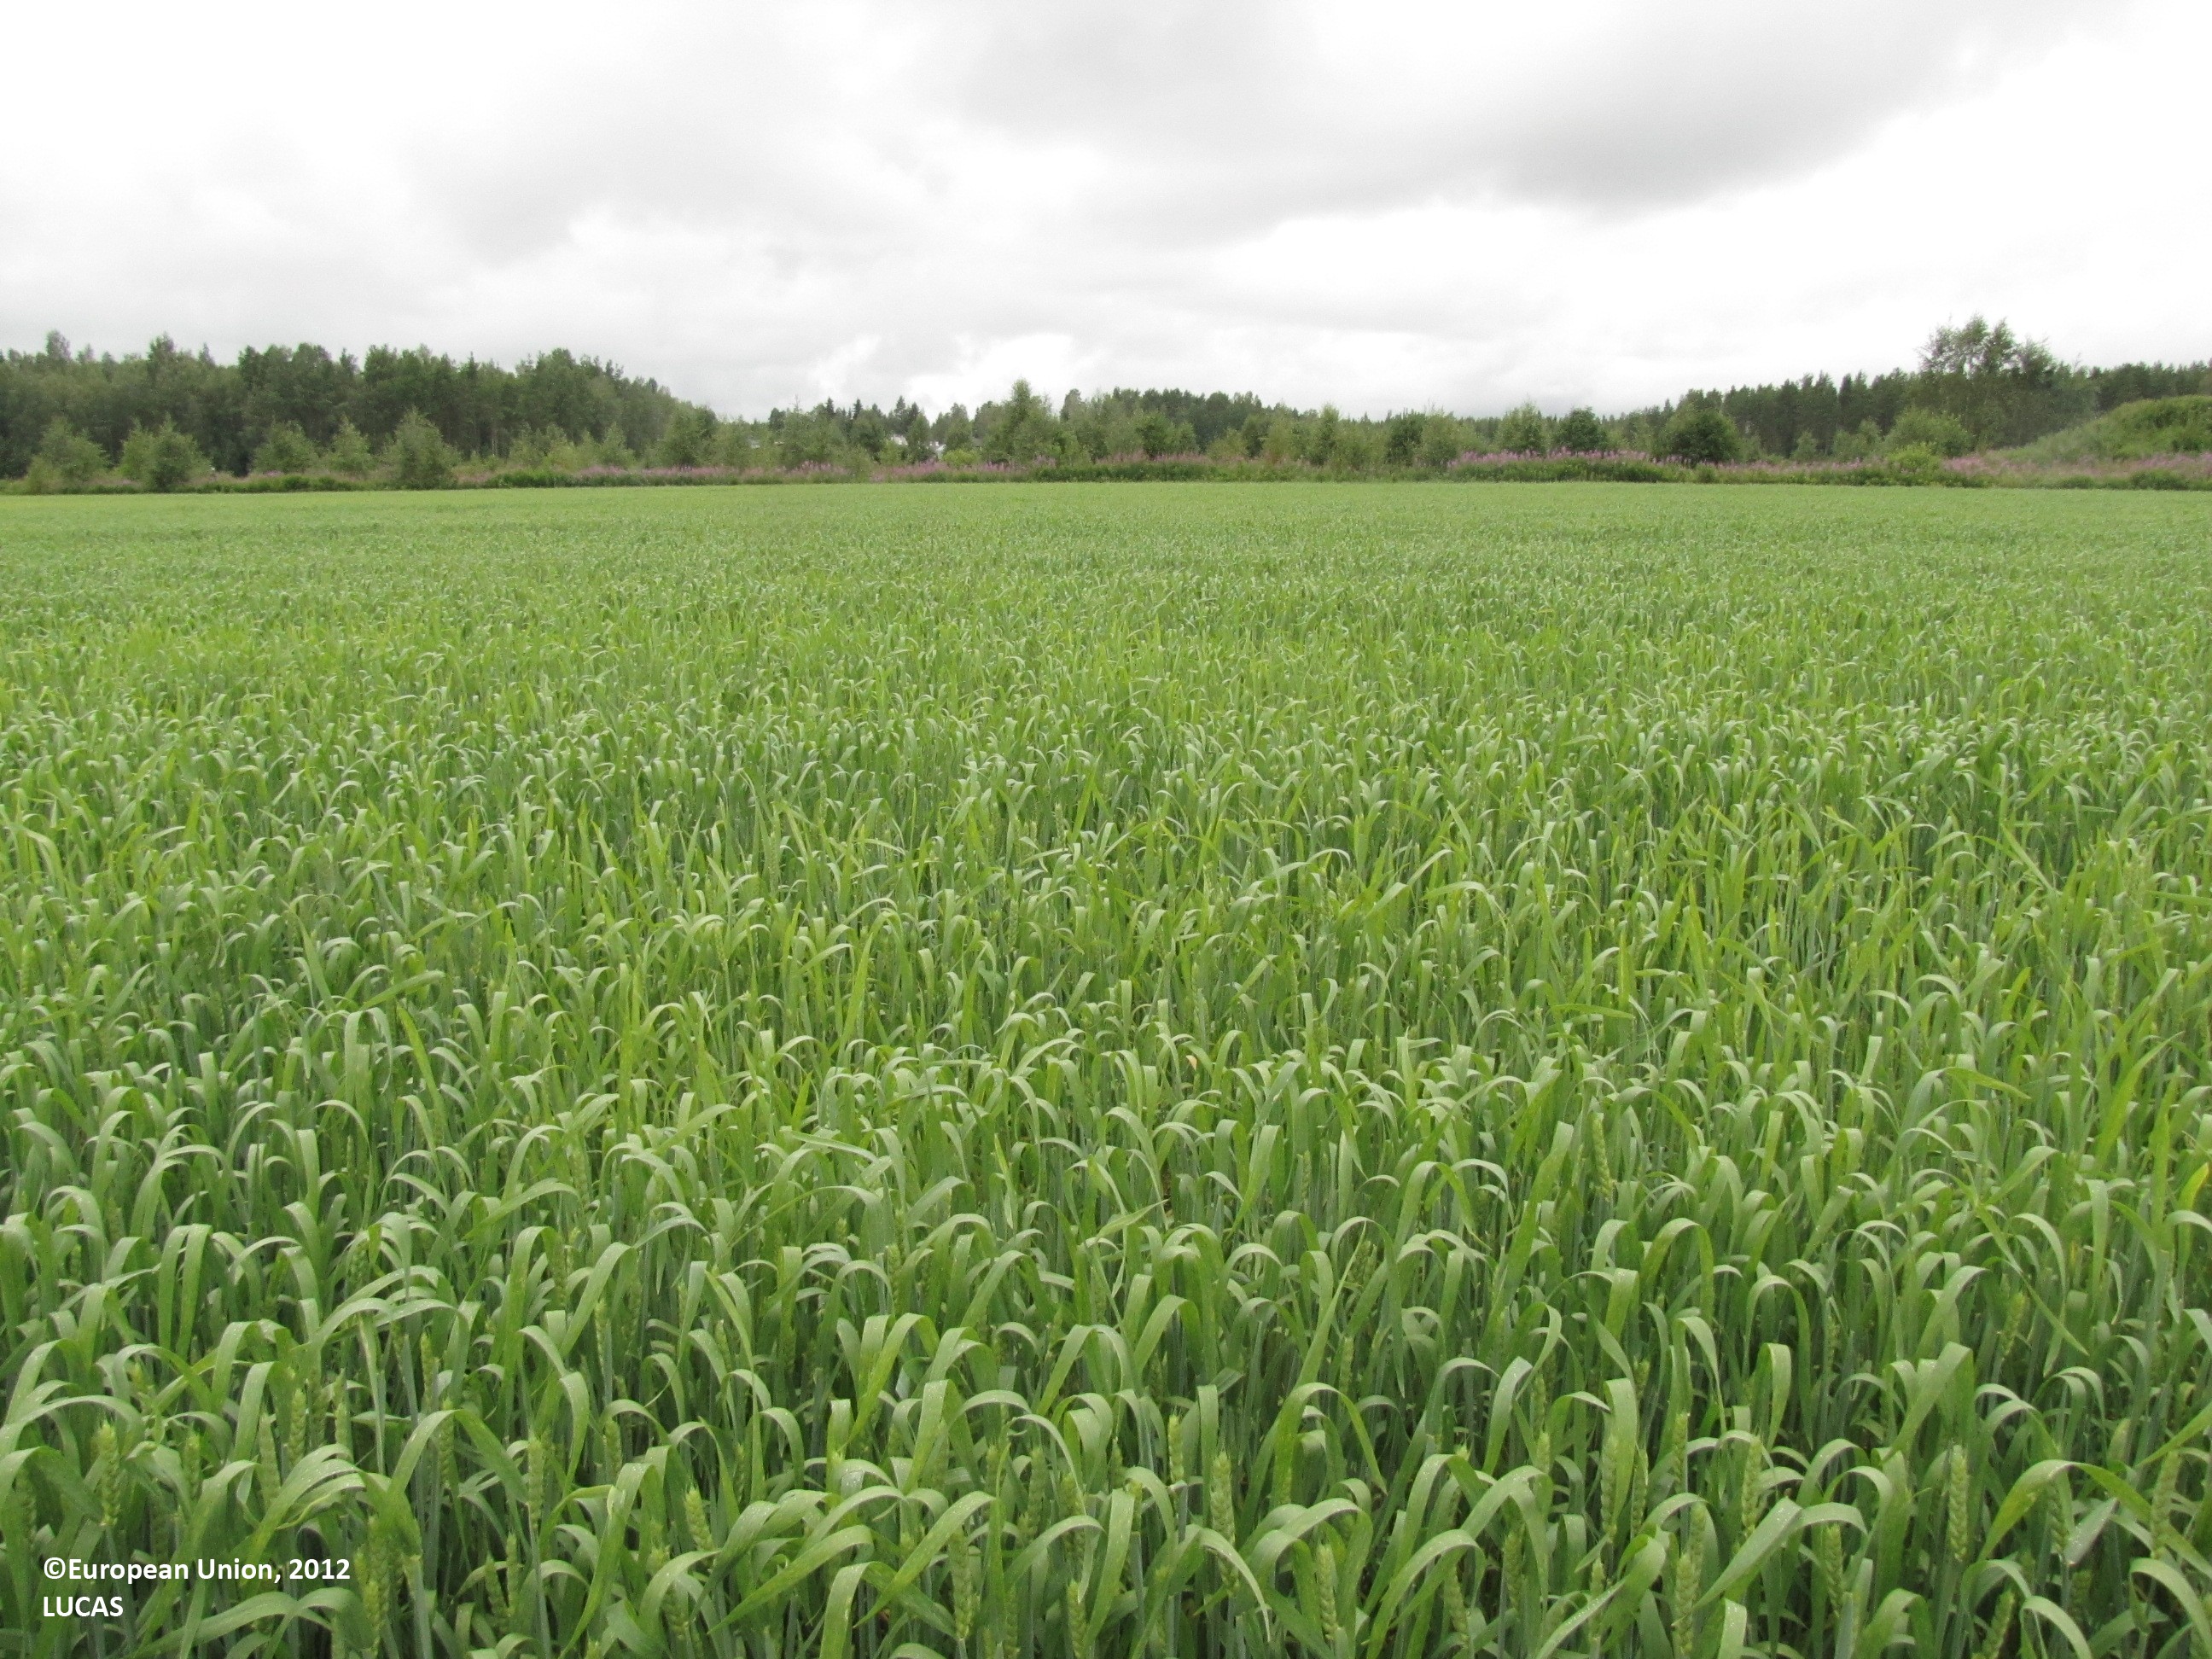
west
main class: Cropland
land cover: Common wheat
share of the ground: > 75 %
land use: Agriculture (excluding fallow land and kitchen gardens)
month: July
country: FI
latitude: 62.4851
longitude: 23.0049
